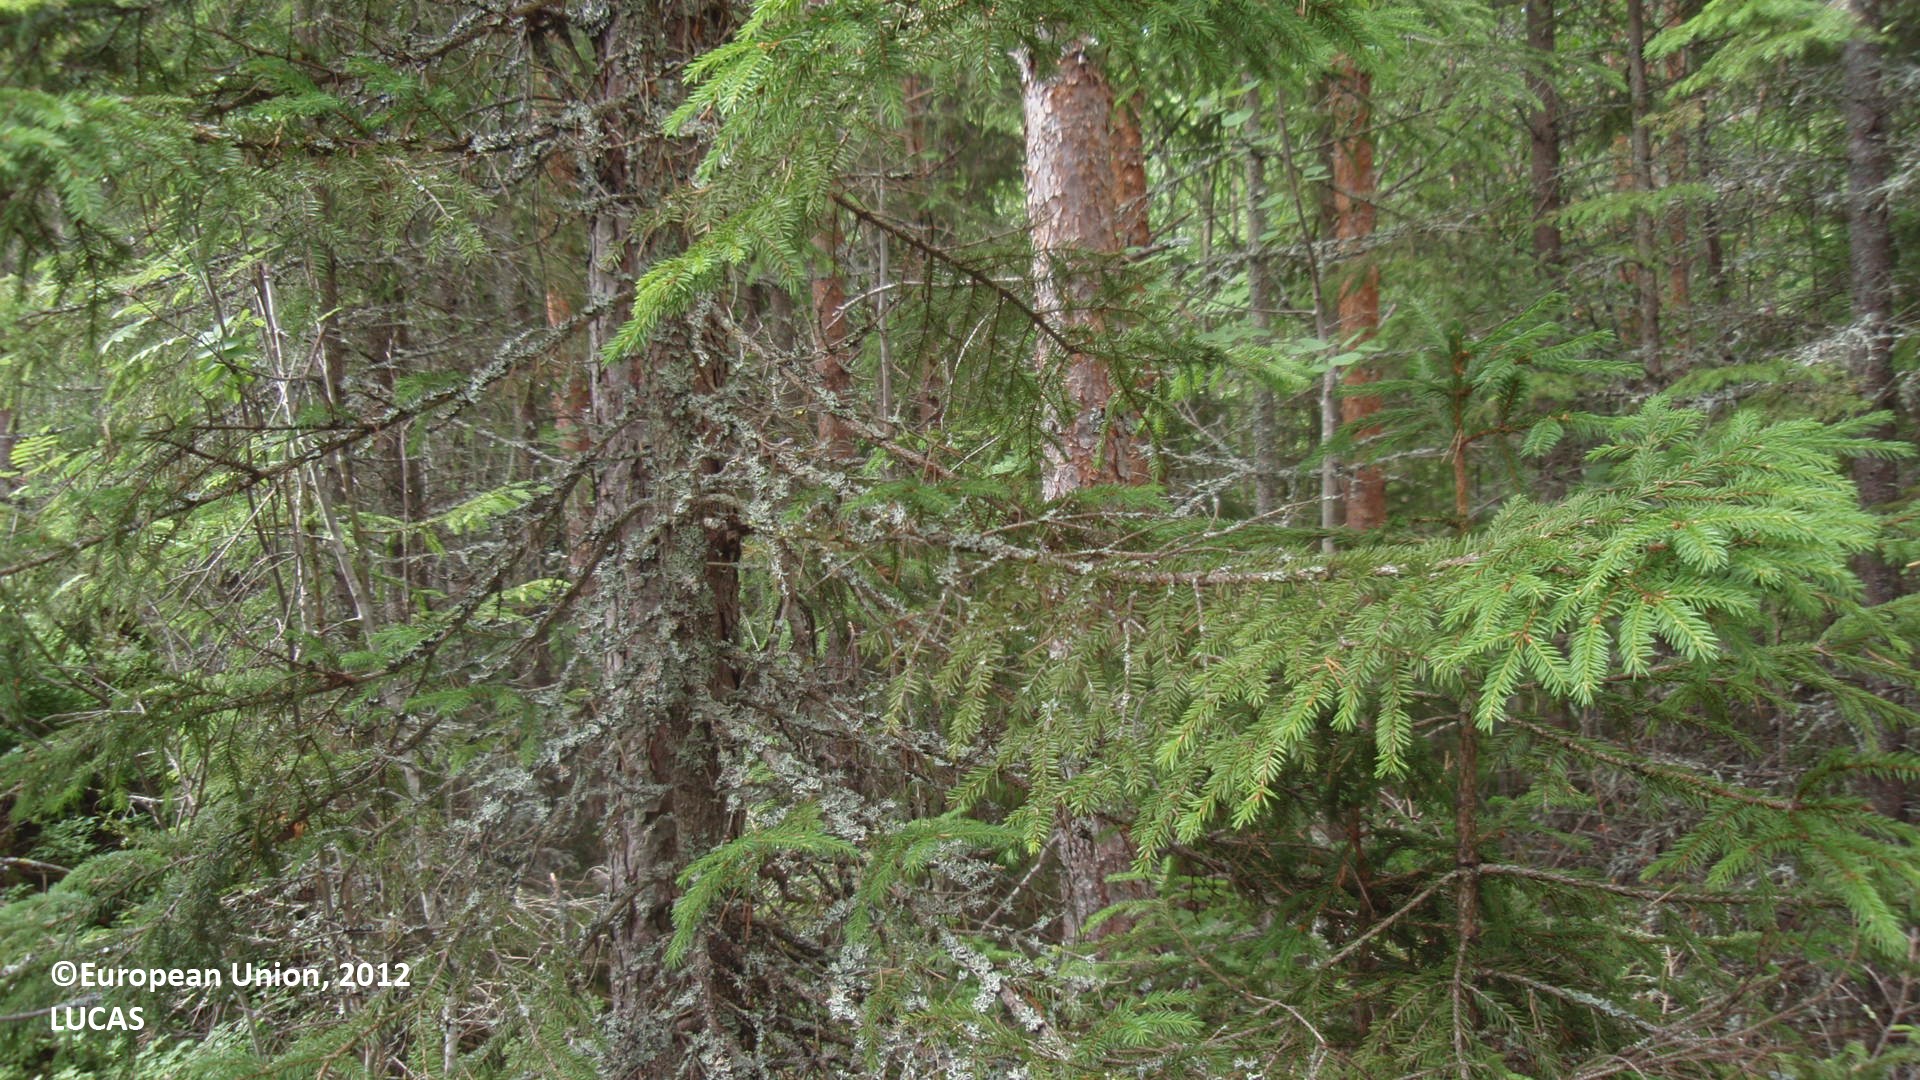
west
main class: Woodland
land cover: Spruce dominated mixed woodland
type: boreal forest
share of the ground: 25 - 50 %
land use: Semi-natural and natural areas not in use
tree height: > 5 m
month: July
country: FI
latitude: 61.6208
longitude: 28.1725
